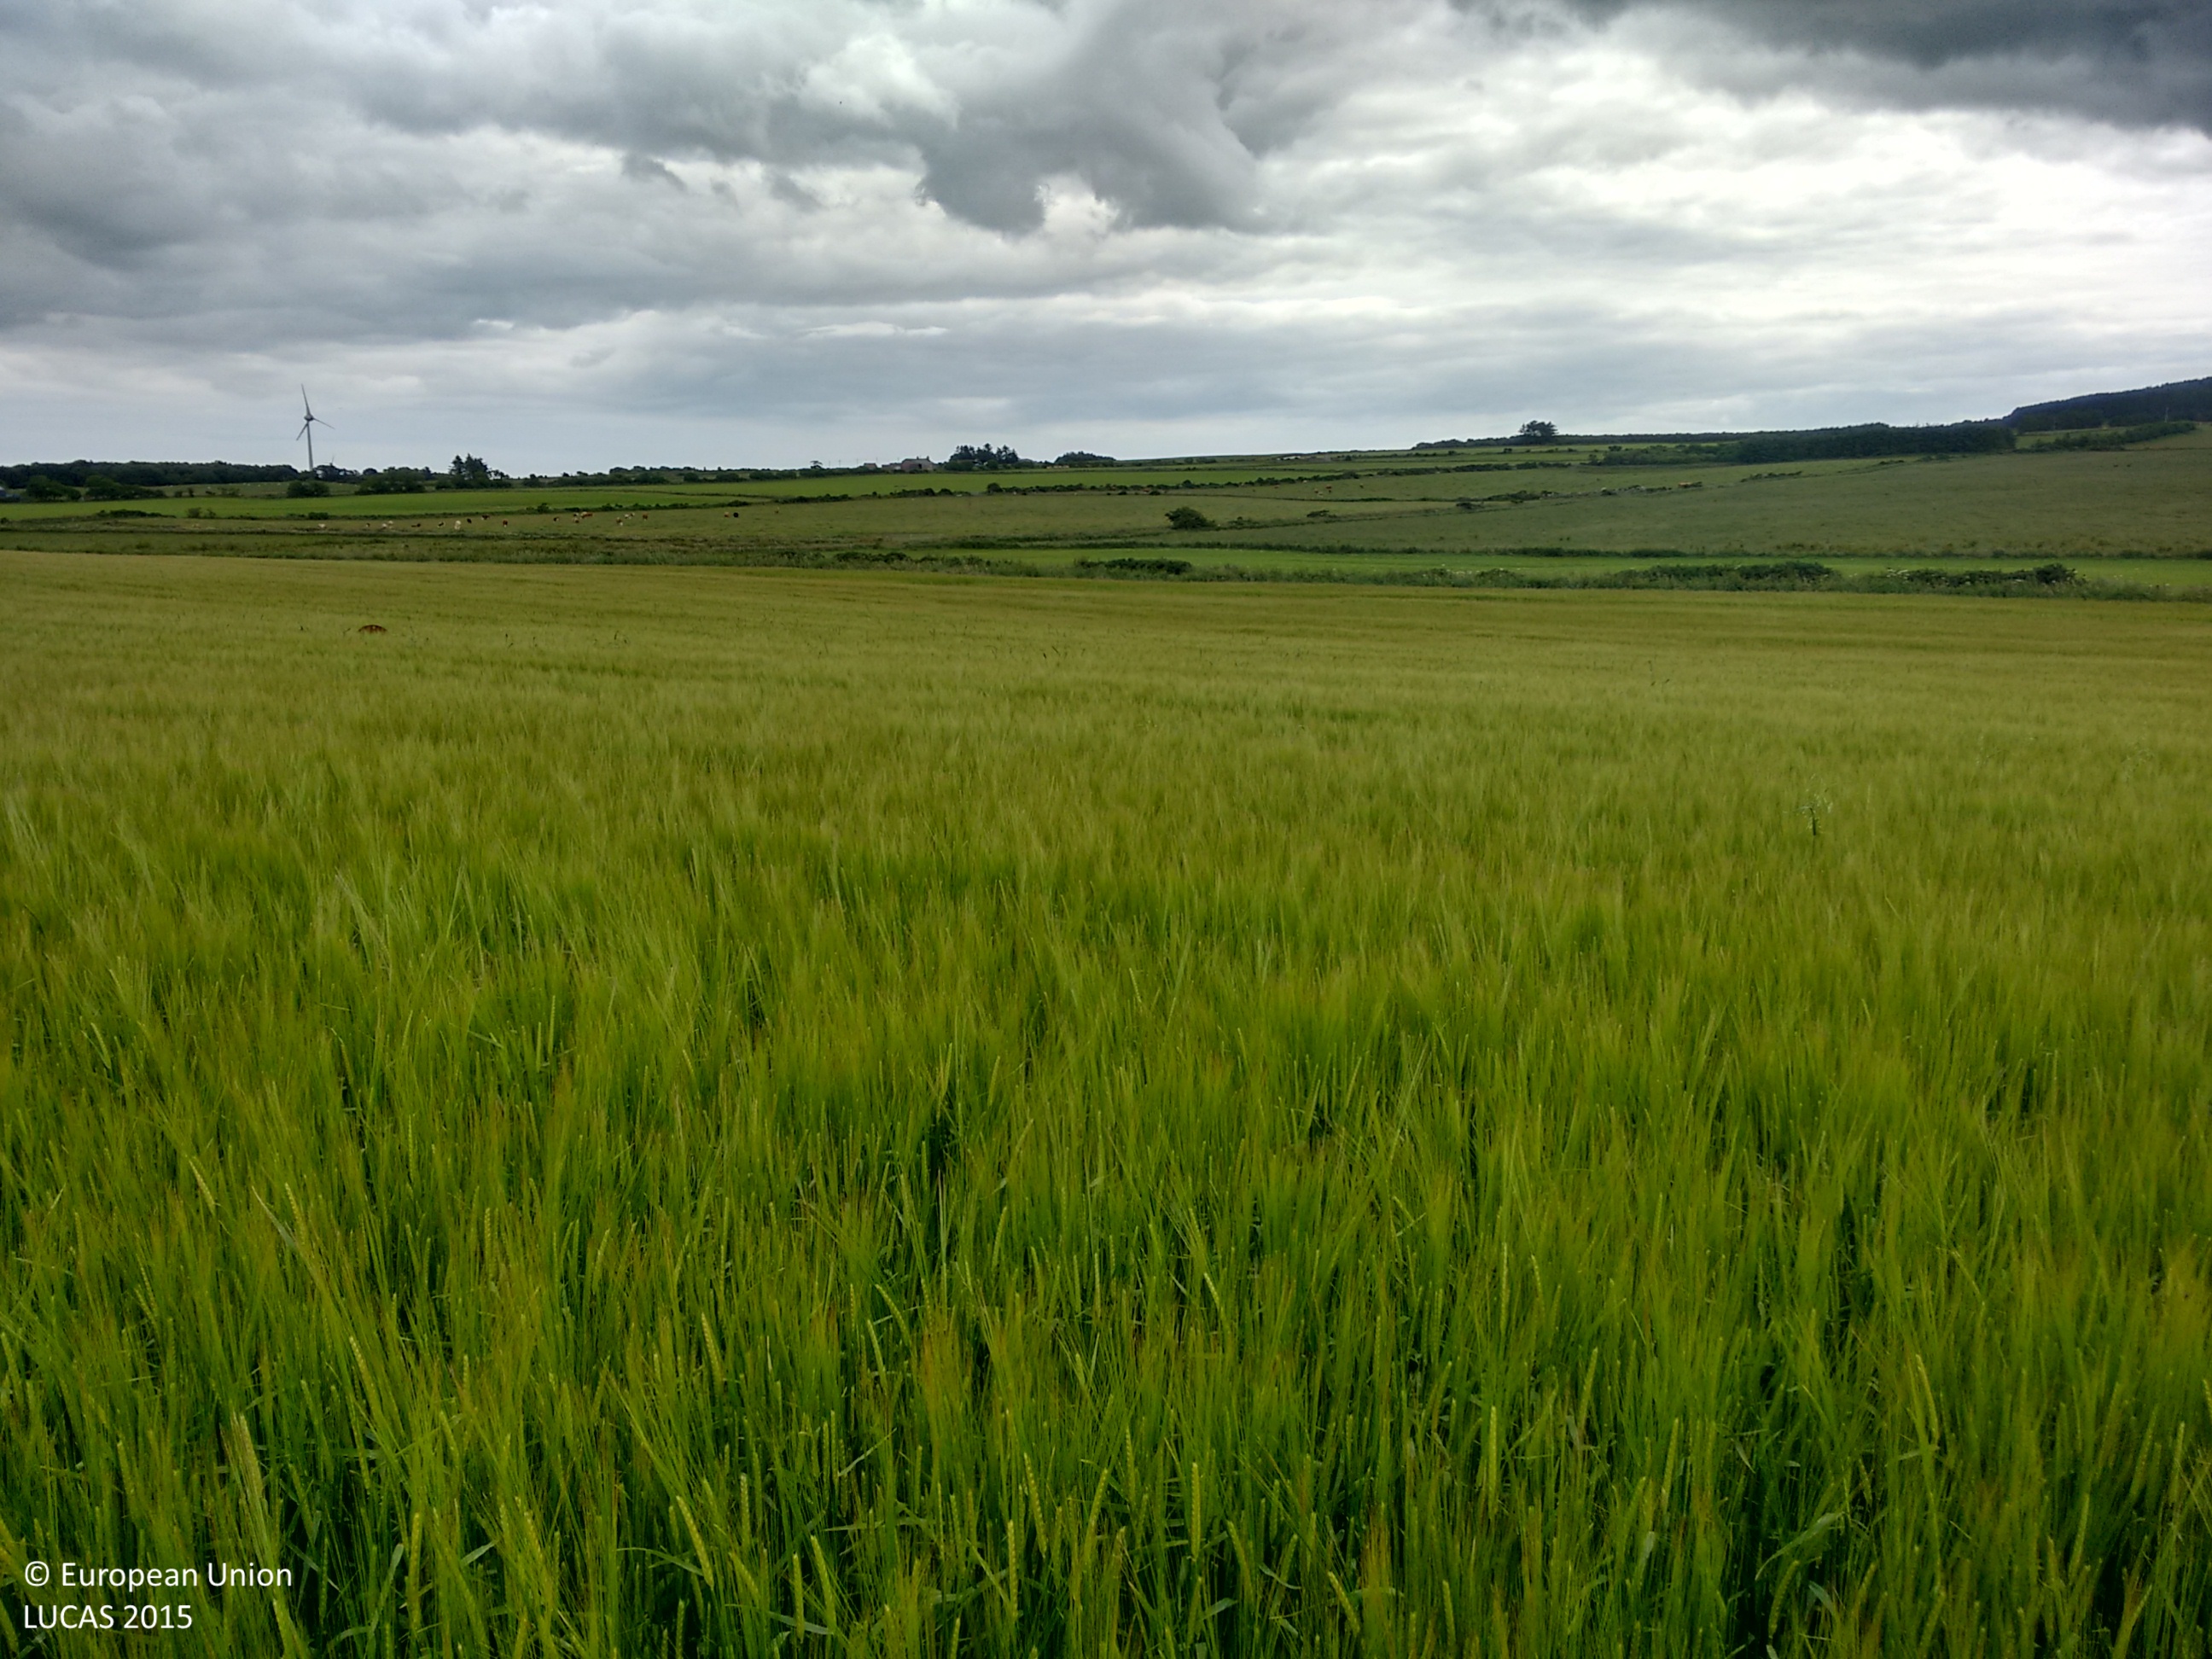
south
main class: Cropland
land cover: Barley
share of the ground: > 75 %
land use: Agriculture (excluding fallow land and kitchen gardens)
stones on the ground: < 10 %
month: July
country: GB
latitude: 57.6234
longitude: -2.0165
